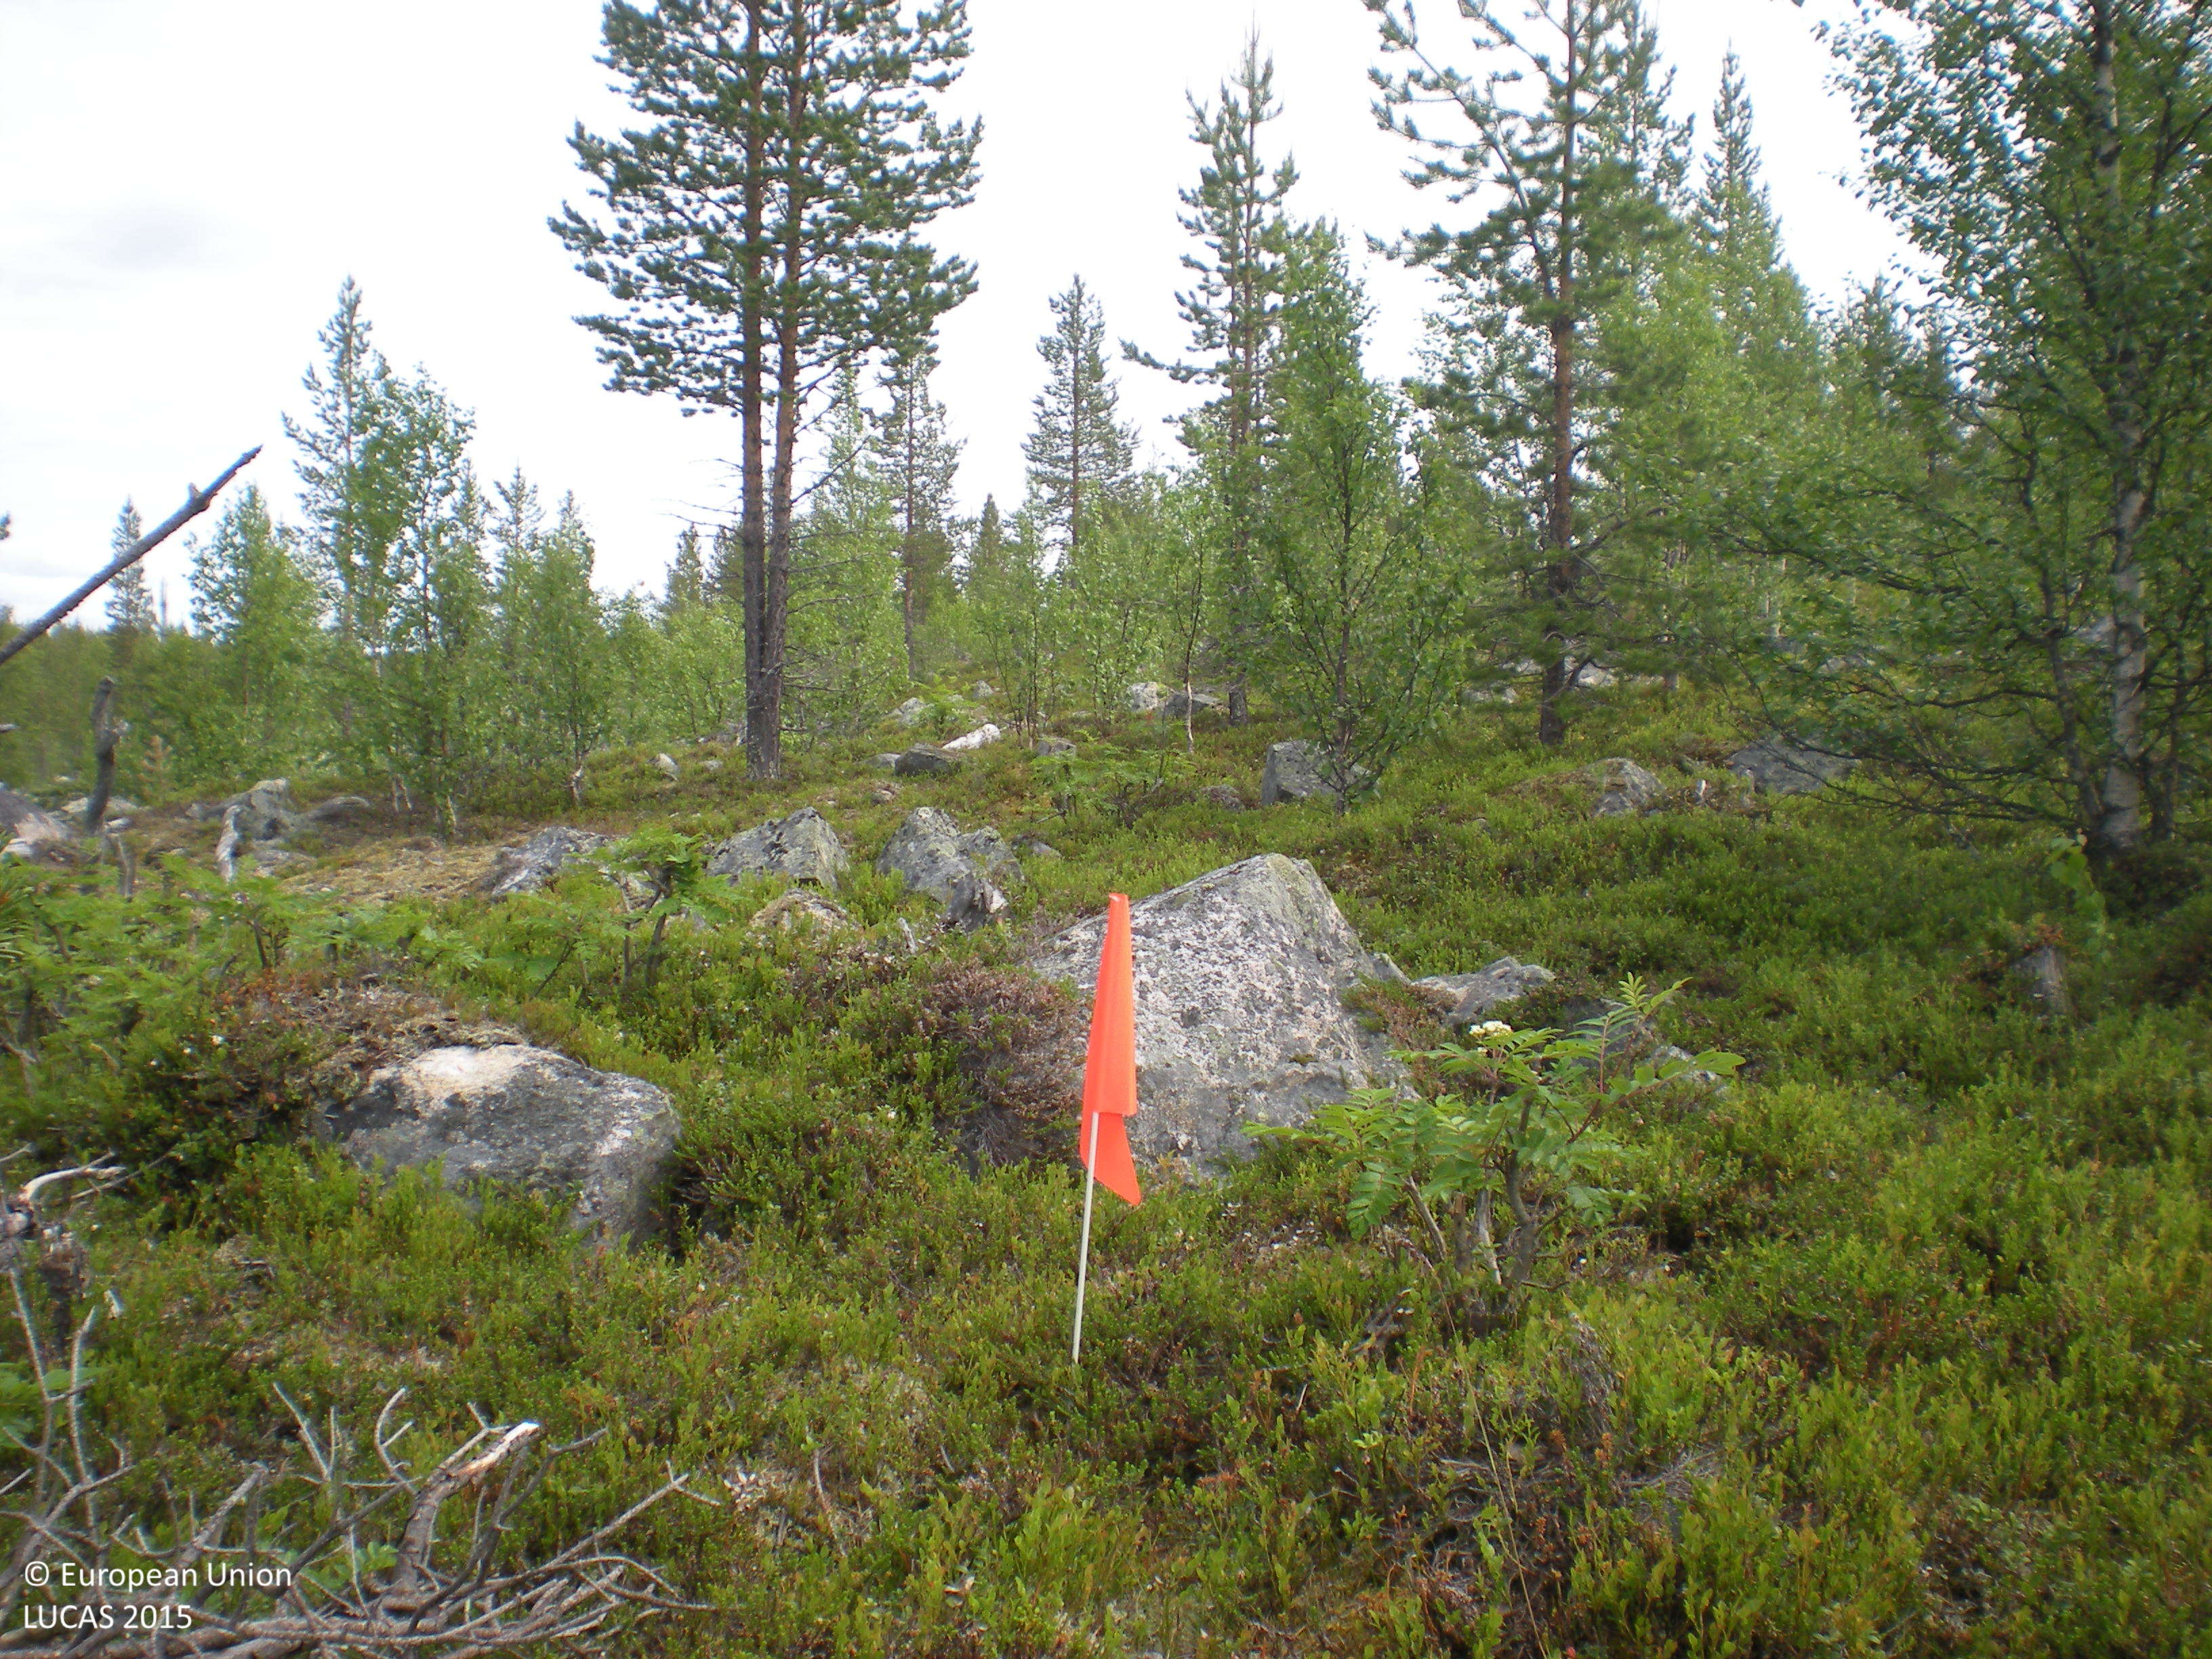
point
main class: Woodland
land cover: Spruce dominated mixed woodland
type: boreal forest
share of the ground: 25 - 50 %
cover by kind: shrubs 40 %, coniferous forest trees 25 %, broadleaved forest trees 20 %, consolidated bare surface 10 %, lichens and mosses 5 %
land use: Forestry
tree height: > 5 m
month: July
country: SE
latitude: 65.5951
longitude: 17.2256
